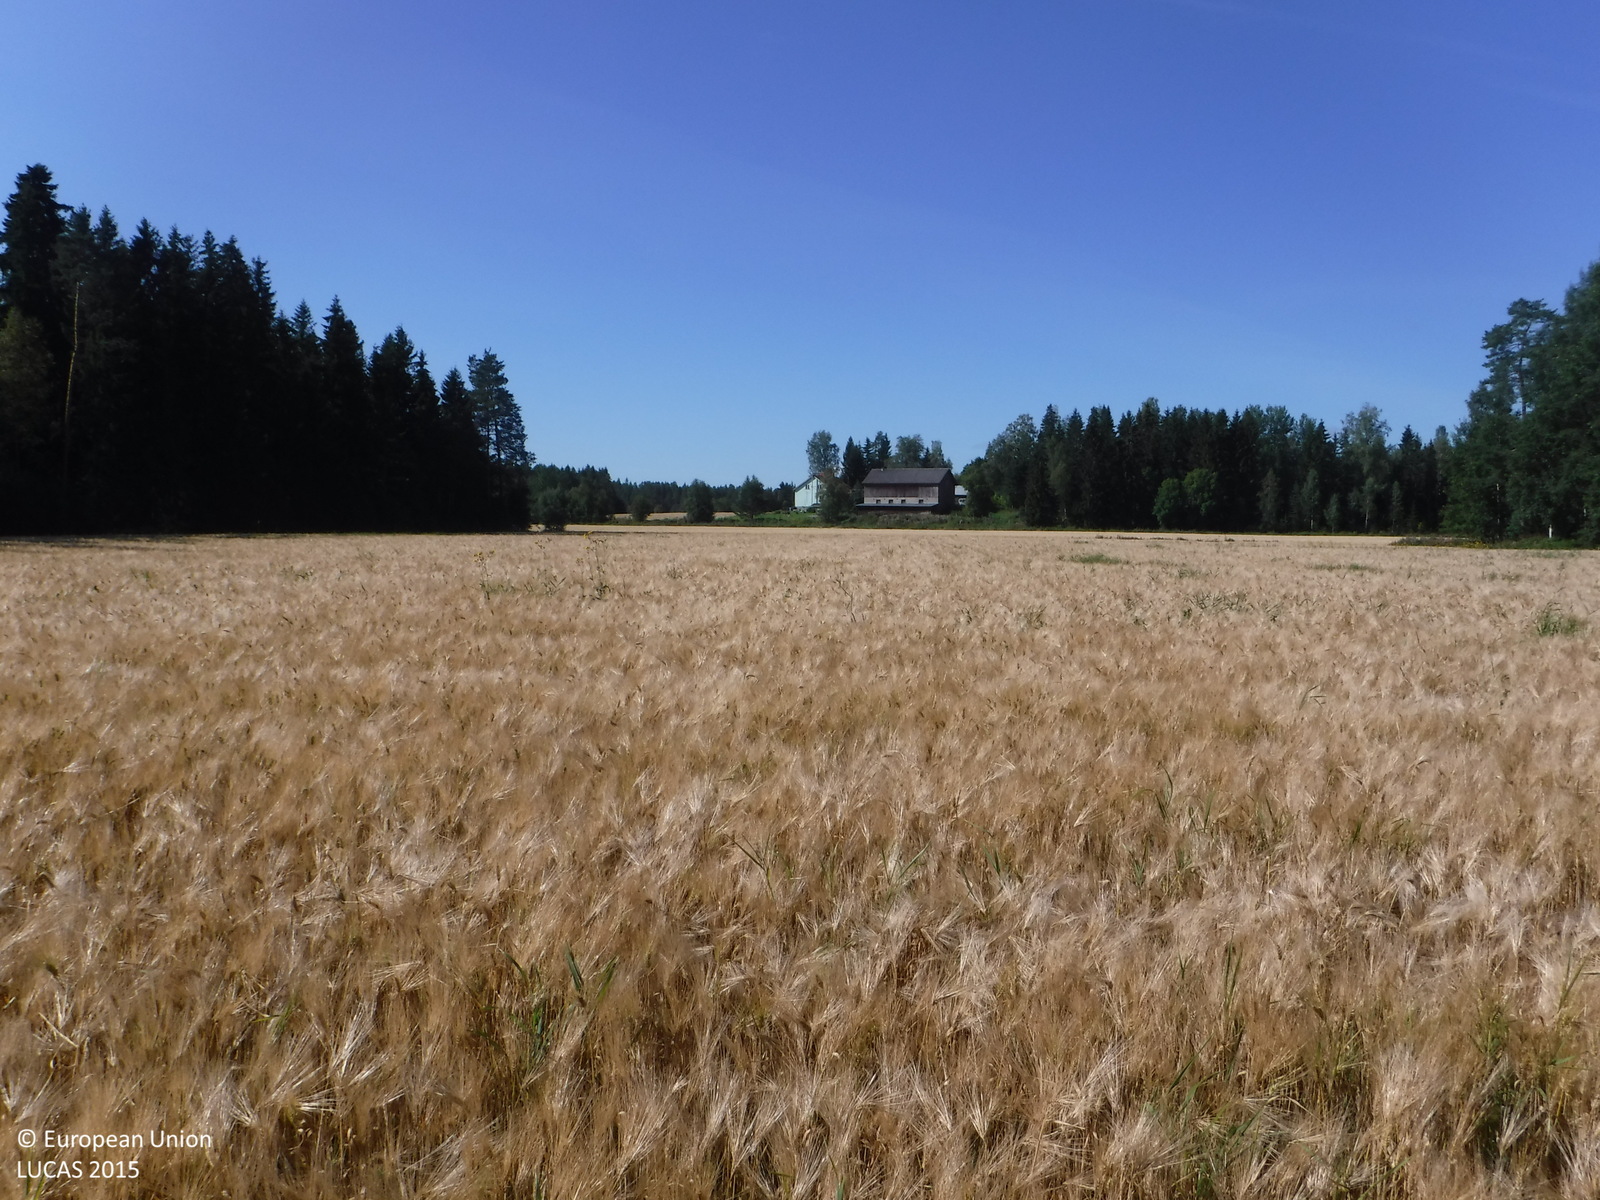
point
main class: Cropland
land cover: Barley
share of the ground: > 75 %
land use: Agriculture (excluding fallow land and kitchen gardens)
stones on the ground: < 10 %
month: August
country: FI
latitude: 61.1297
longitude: 21.7340
